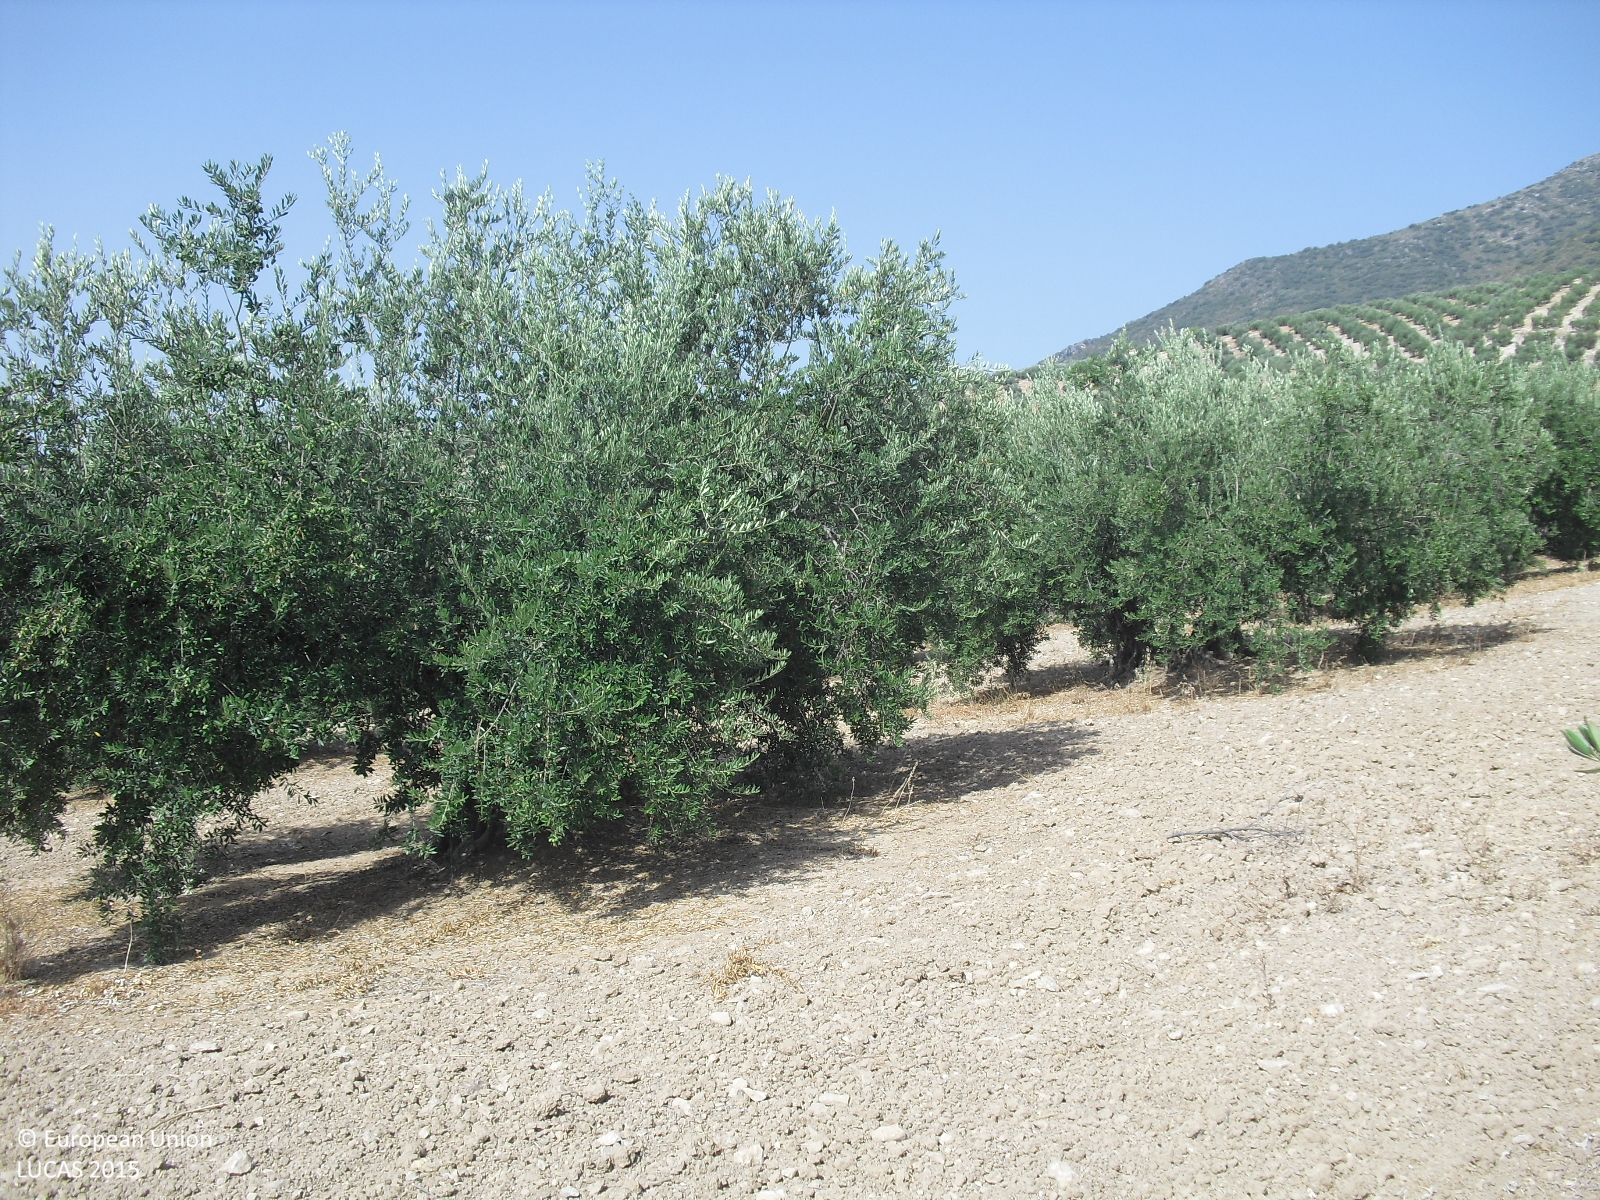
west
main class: Cropland
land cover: Olive groves
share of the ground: 25 - 50 %
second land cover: Other bare soil
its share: > 75 %
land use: Agriculture (excluding fallow land and kitchen gardens)
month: August
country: ES
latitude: 37.3721
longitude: -4.2158
